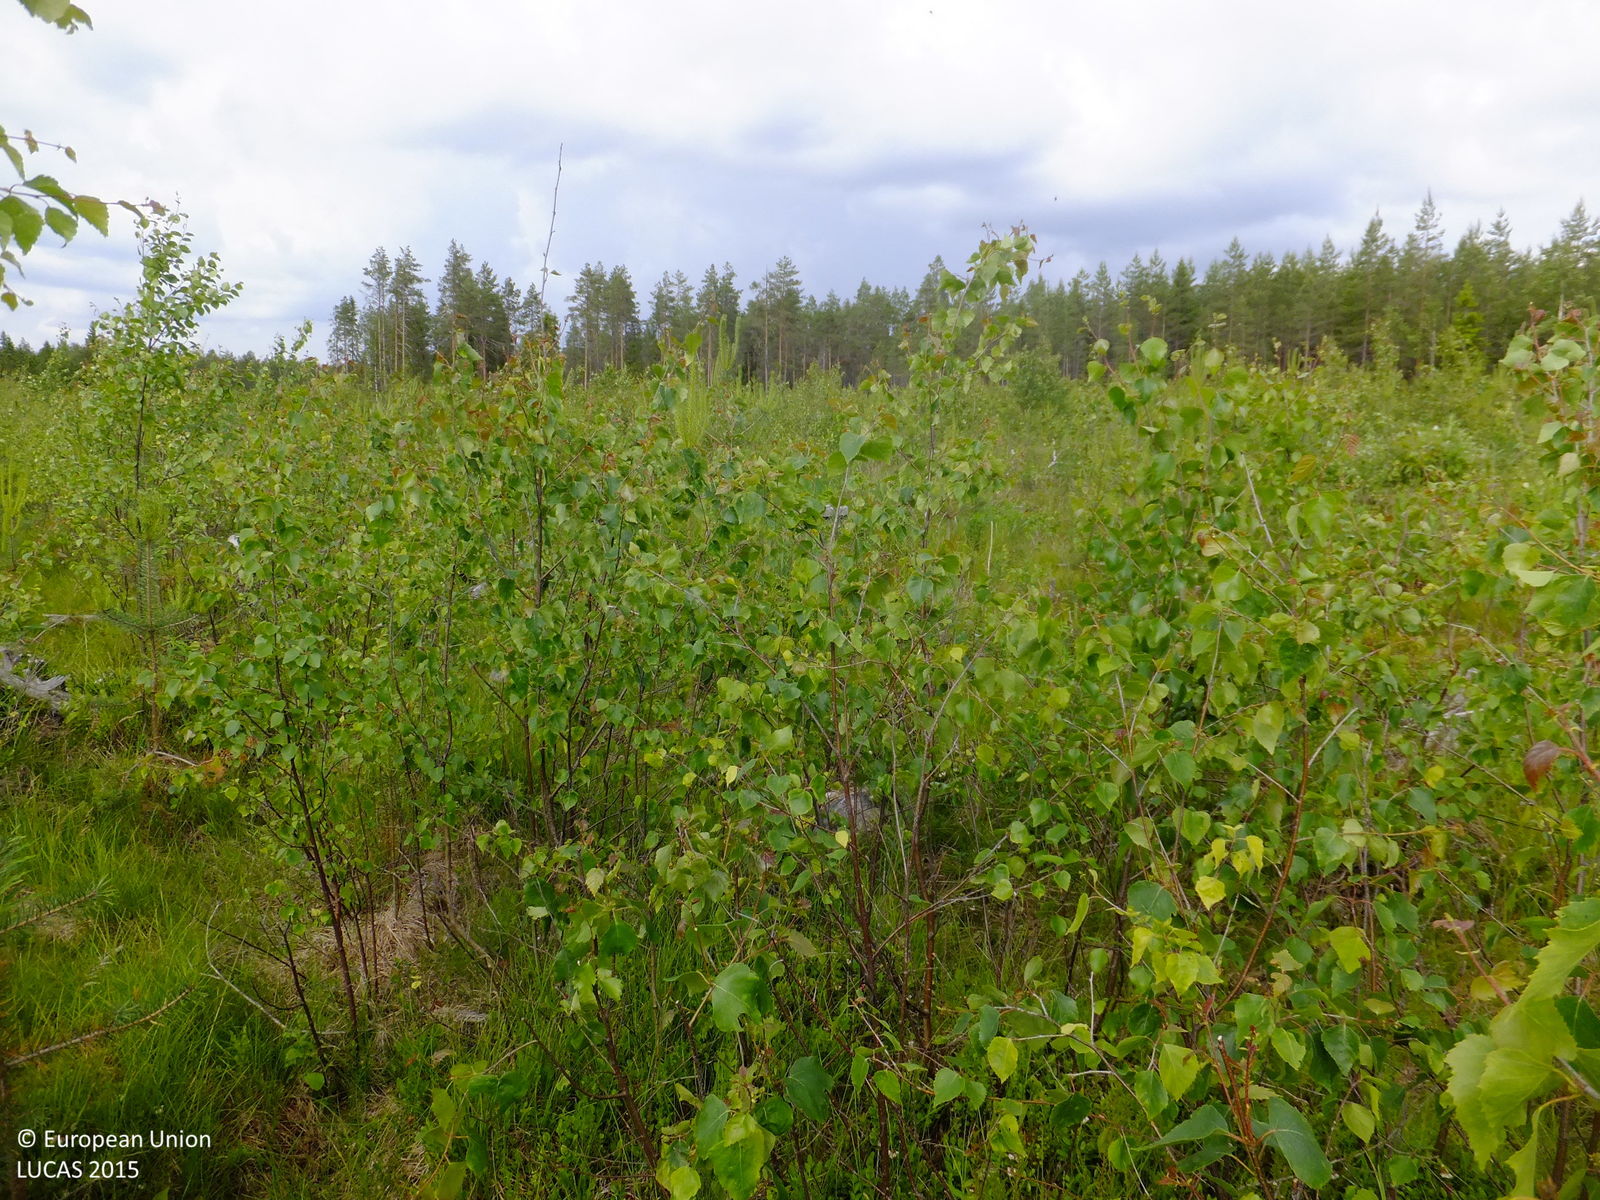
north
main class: Woodland
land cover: Pine dominated mixed woodland
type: boreal forest
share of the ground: 50 - 75 %
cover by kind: coniferous forest trees 30 %, broadleaved forest trees 30 %, herbaceous plants 20 %, shrubs 10 %, lichens and mosses 10 %
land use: Forestry
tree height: < 5 m
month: June
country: FI
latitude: 63.2448
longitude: 23.9497
